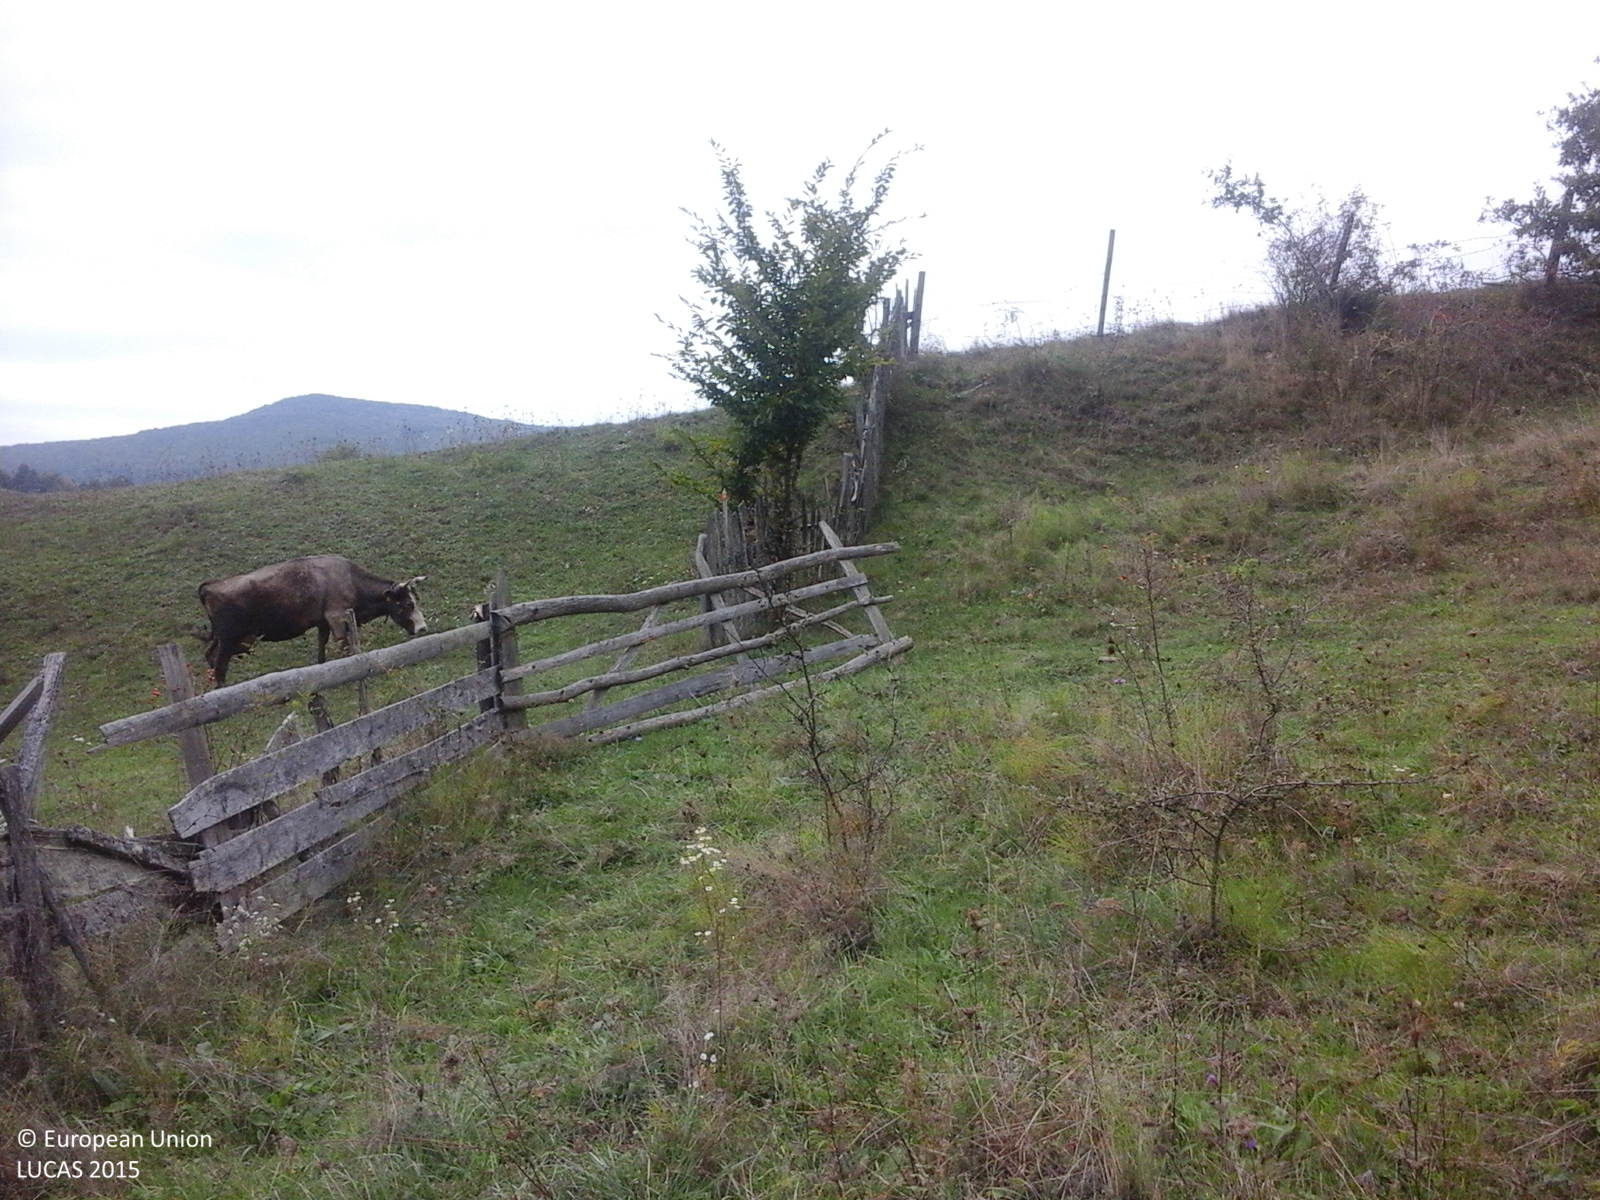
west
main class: Grassland
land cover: Spontaneously vegetated surfaces
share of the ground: > 75 %
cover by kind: herbaceous plants 100 %
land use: Fallow land
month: October
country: RO
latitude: 46.8164
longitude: 24.9213
